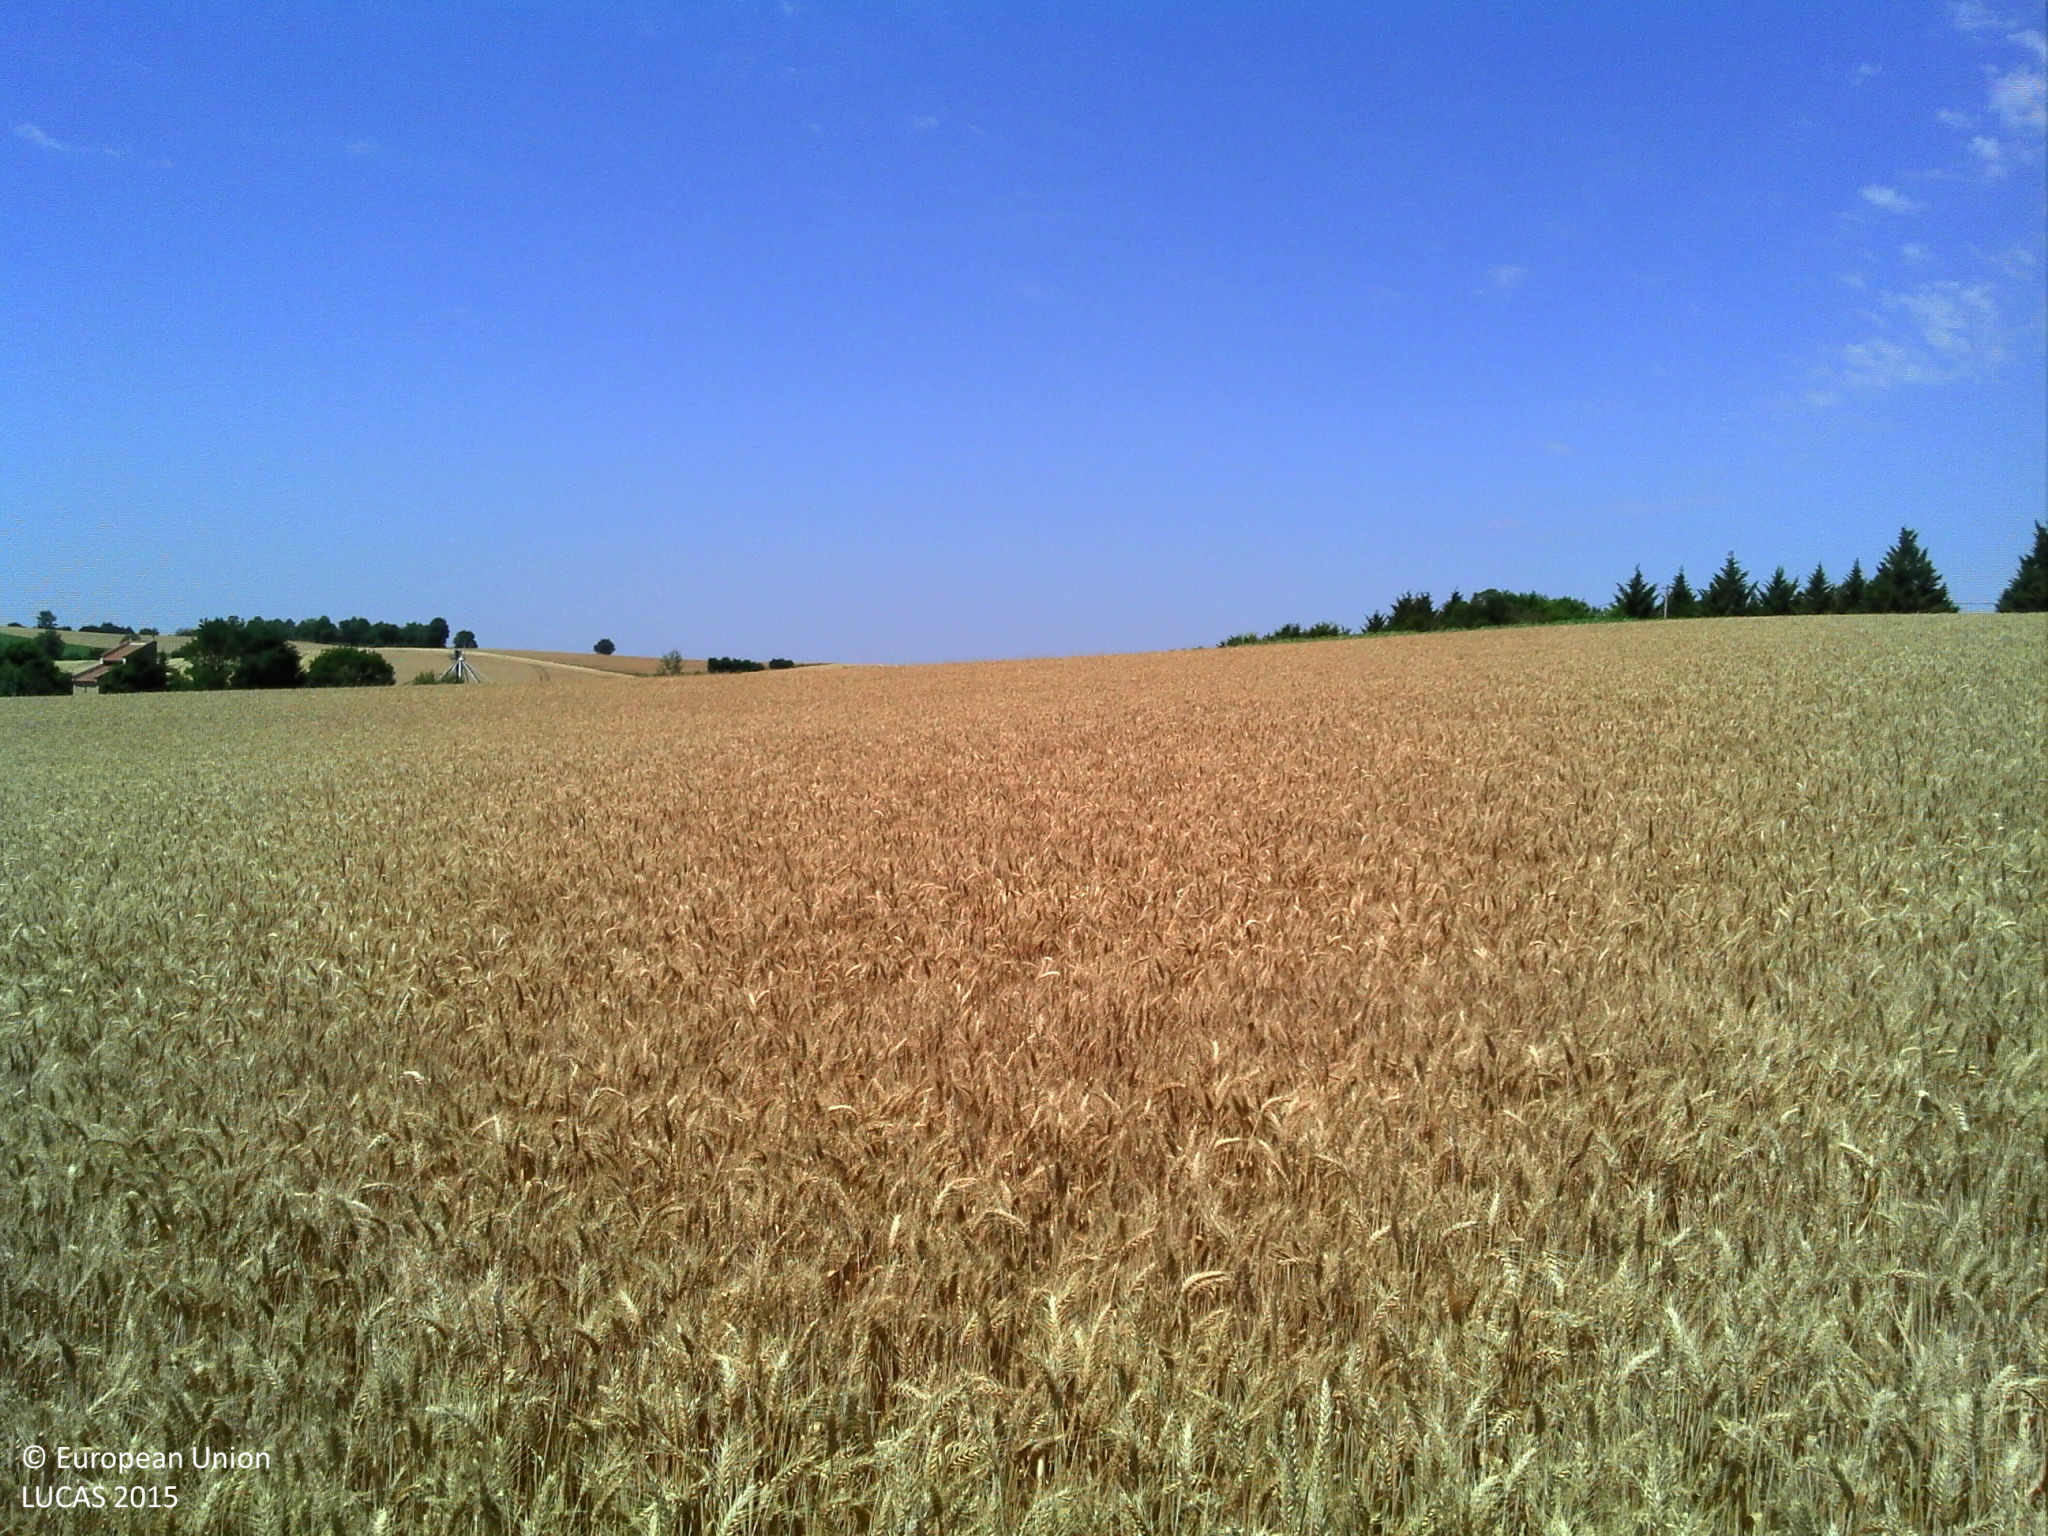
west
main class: Cropland
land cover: Common wheat
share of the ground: > 75 %
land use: Agriculture (excluding fallow land and kitchen gardens)
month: June
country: FR
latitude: 43.7745
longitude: 0.9670
